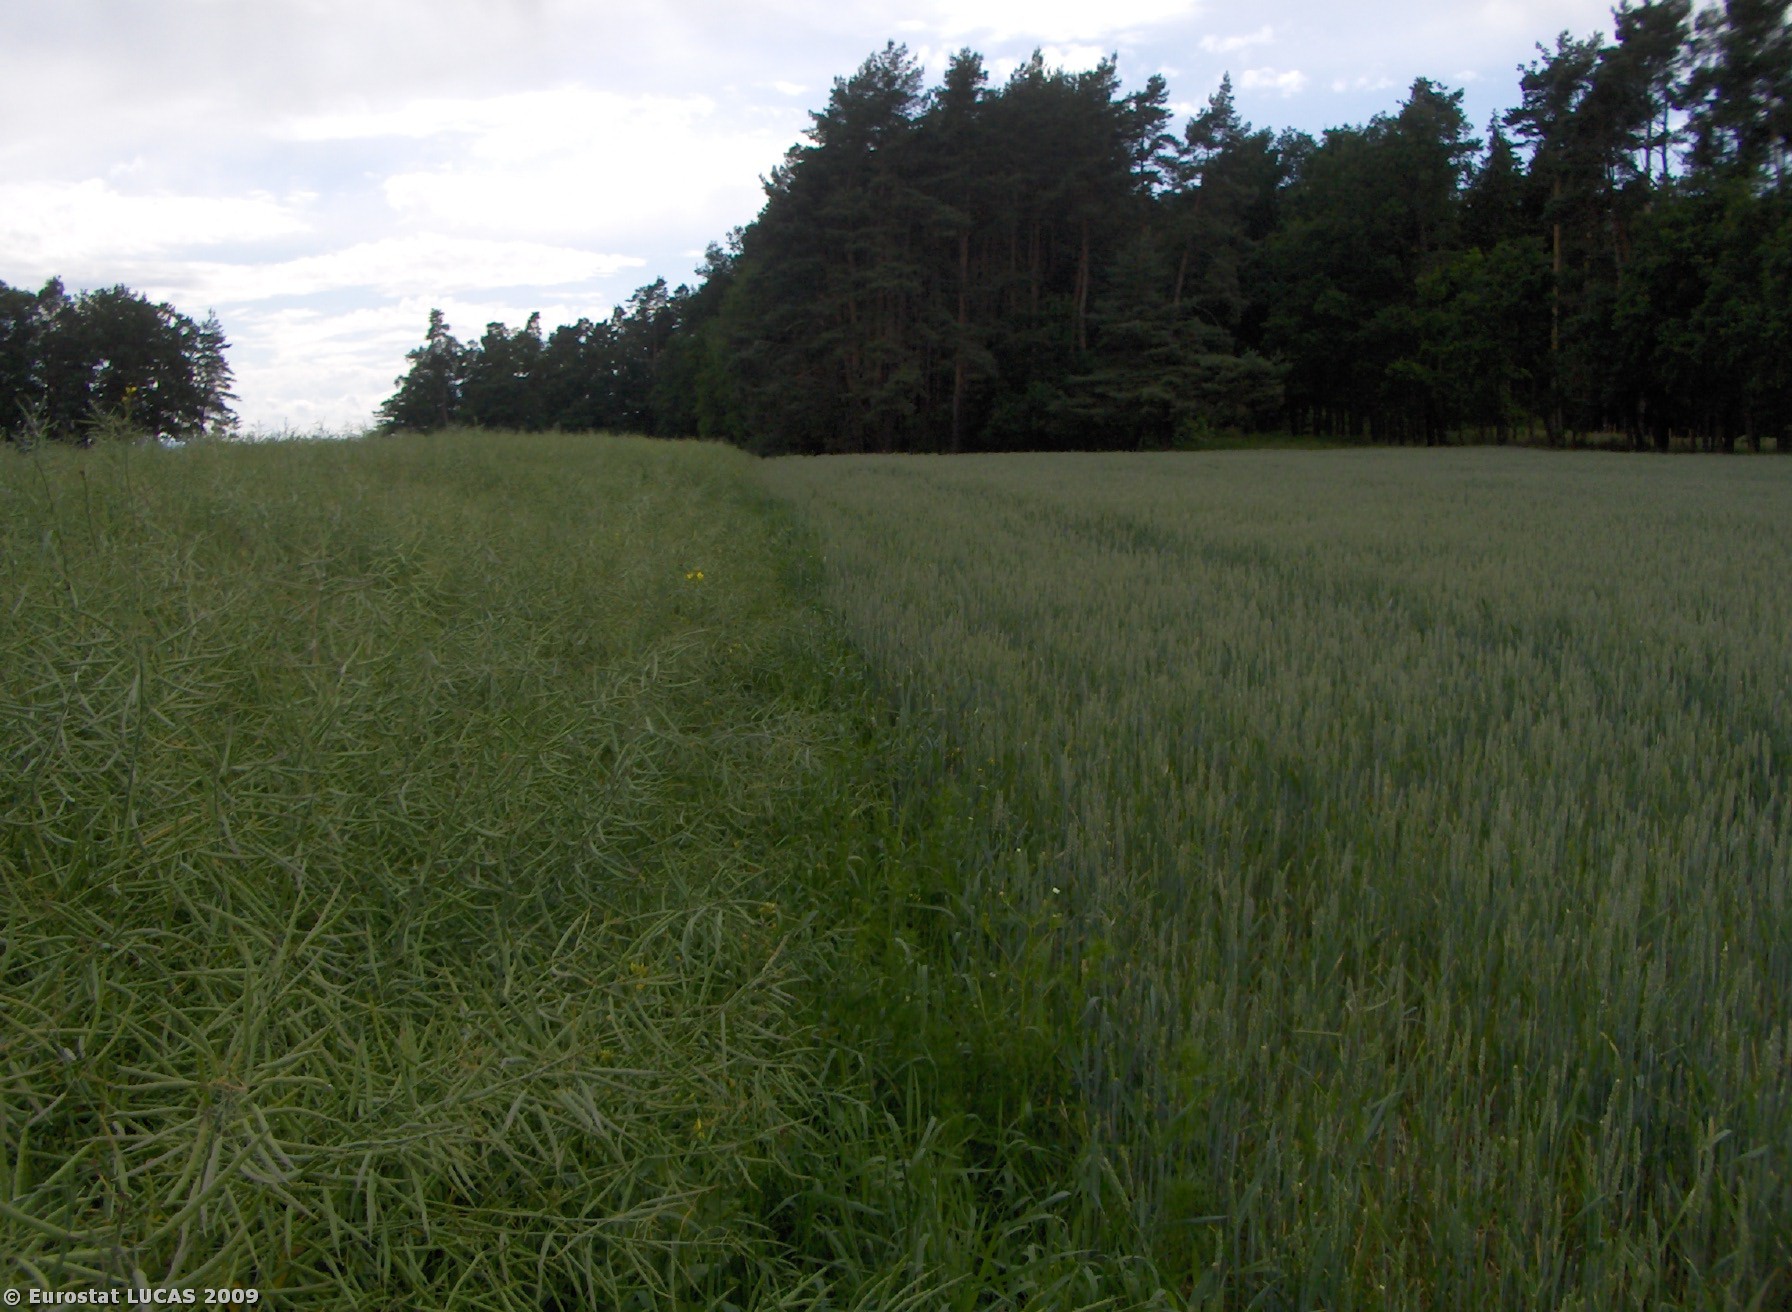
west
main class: Cropland
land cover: Rape and turnip rape
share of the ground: > 75 %
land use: Agriculture (excluding fallow land and kitchen gardens)
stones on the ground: < 10 %
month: June
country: CZ
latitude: 49.1299
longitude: 14.3179
